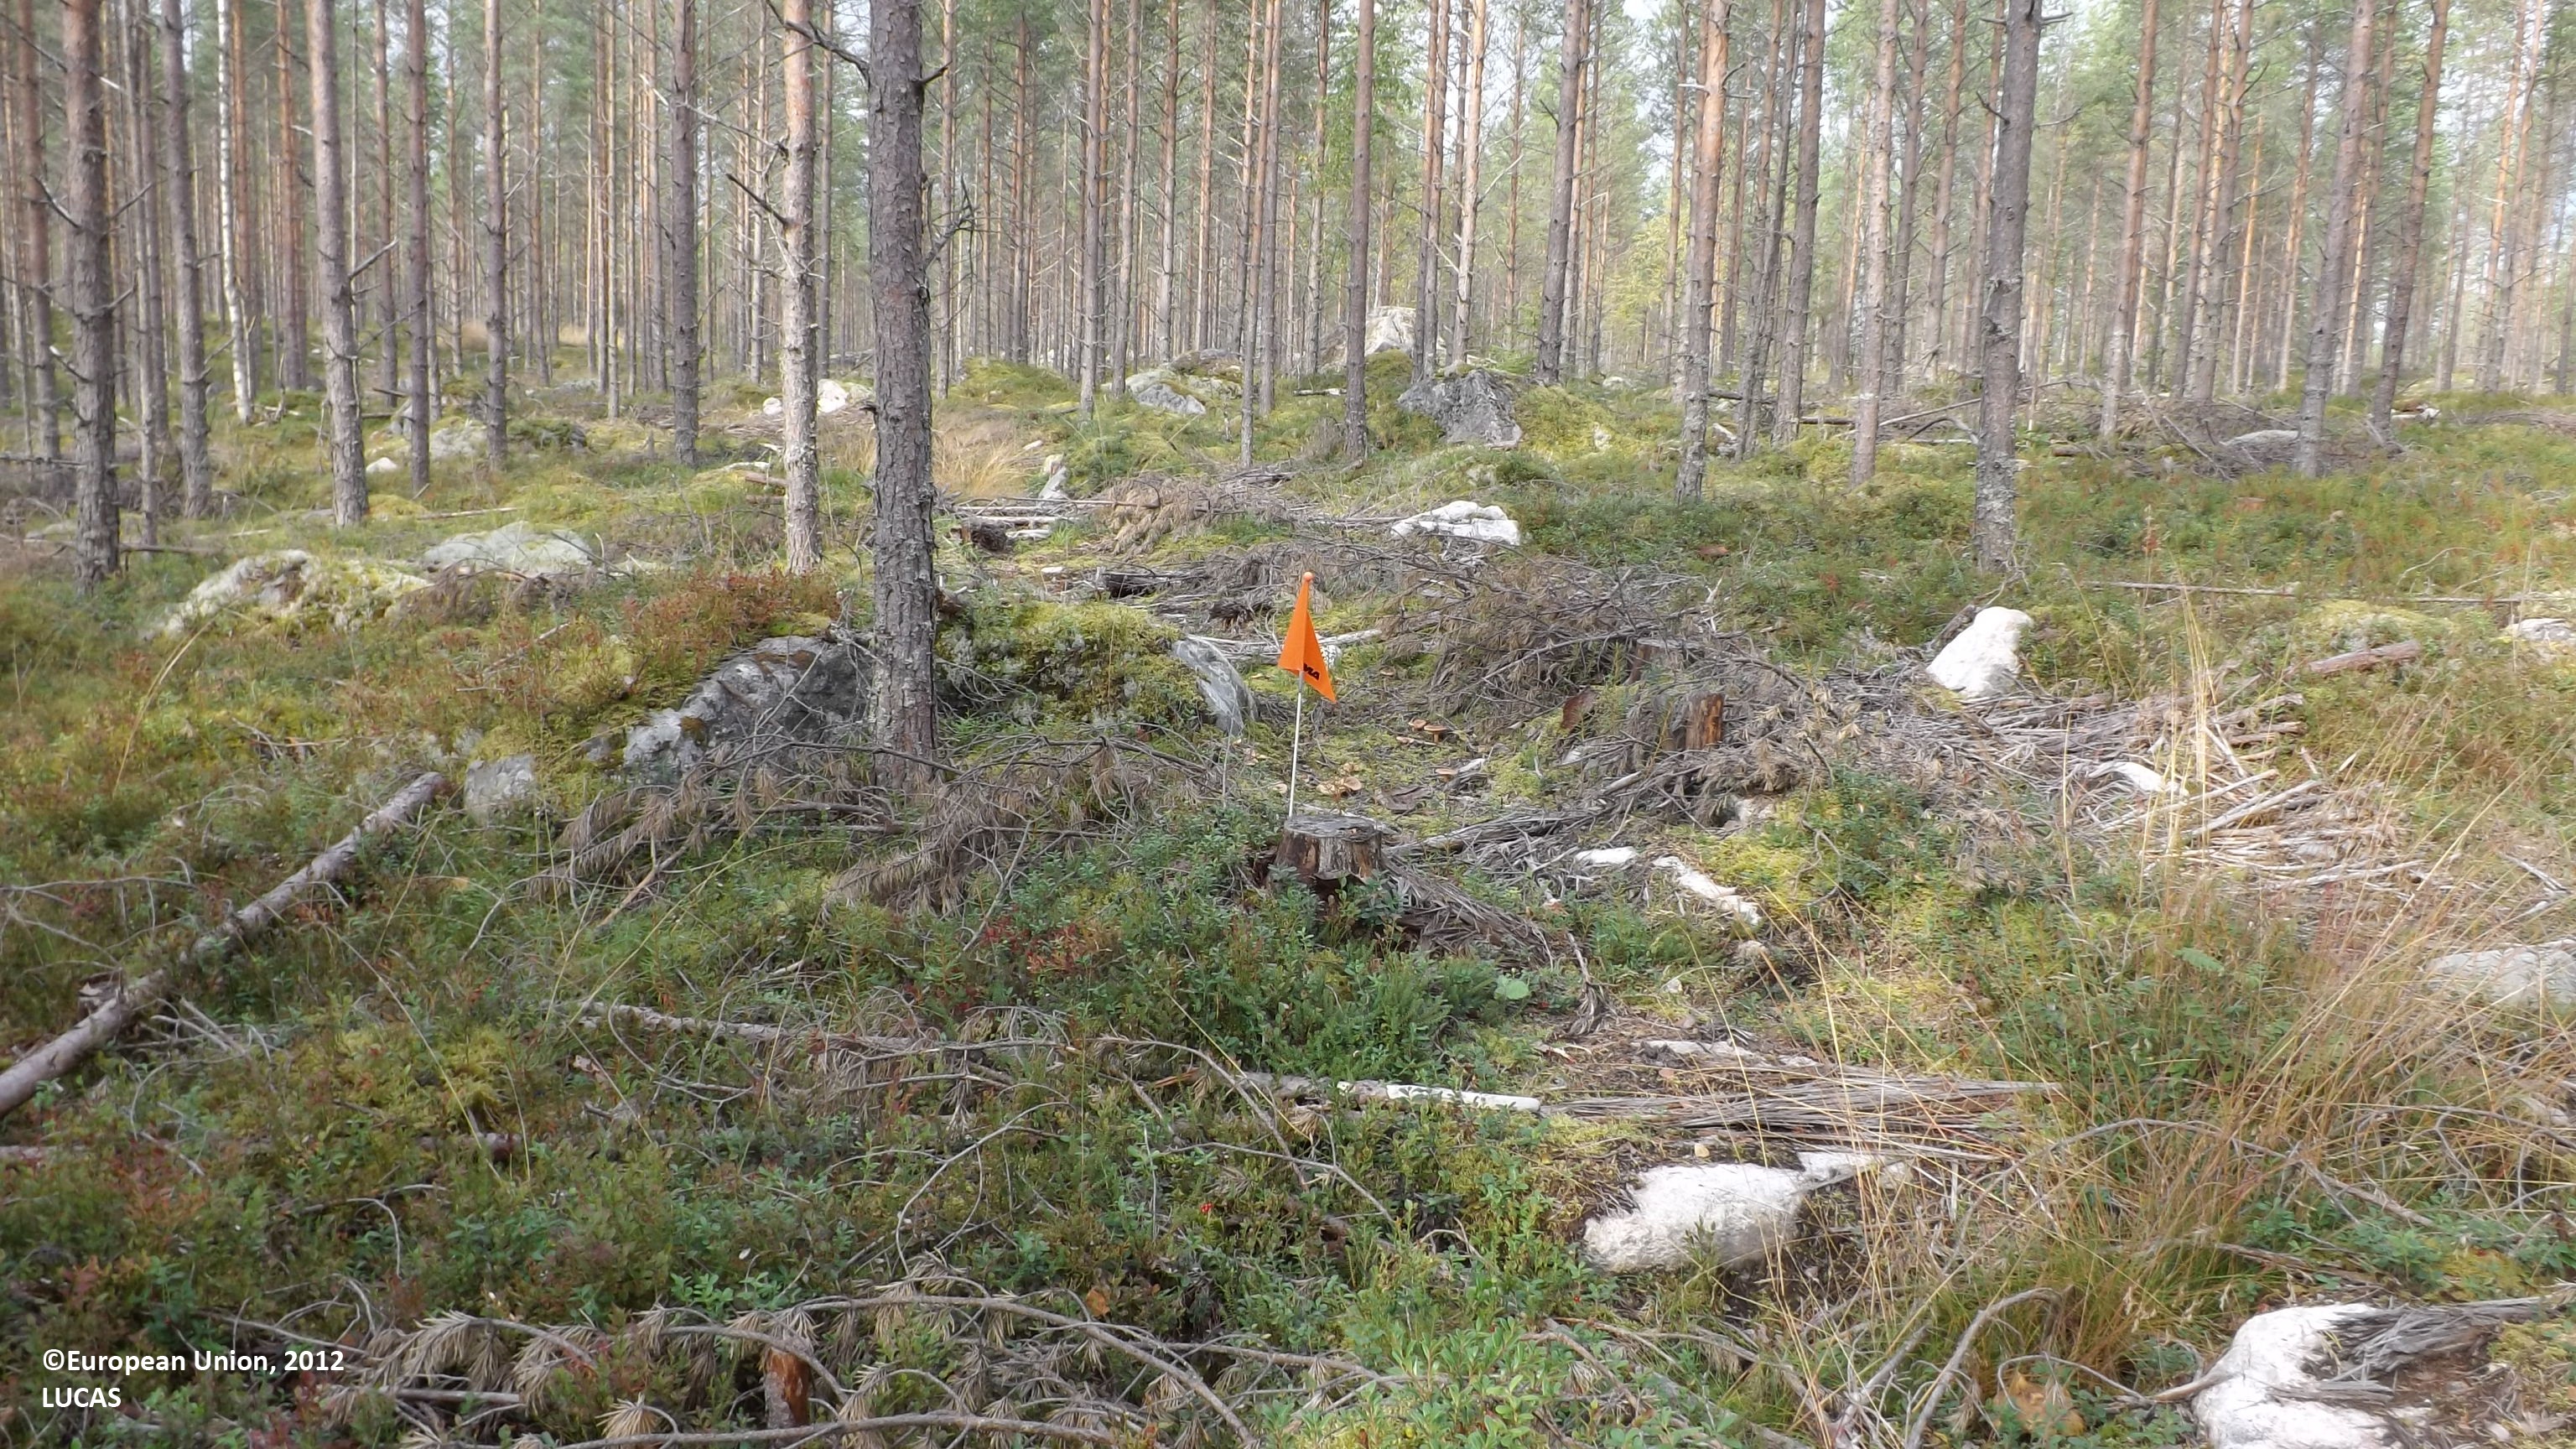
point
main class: Woodland
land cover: Pine dominated coniferous woodland
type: boreal forest
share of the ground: 25 - 50 %
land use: Forestry
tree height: > 5 m
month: August
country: FI
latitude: 63.7595
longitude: 23.7470
